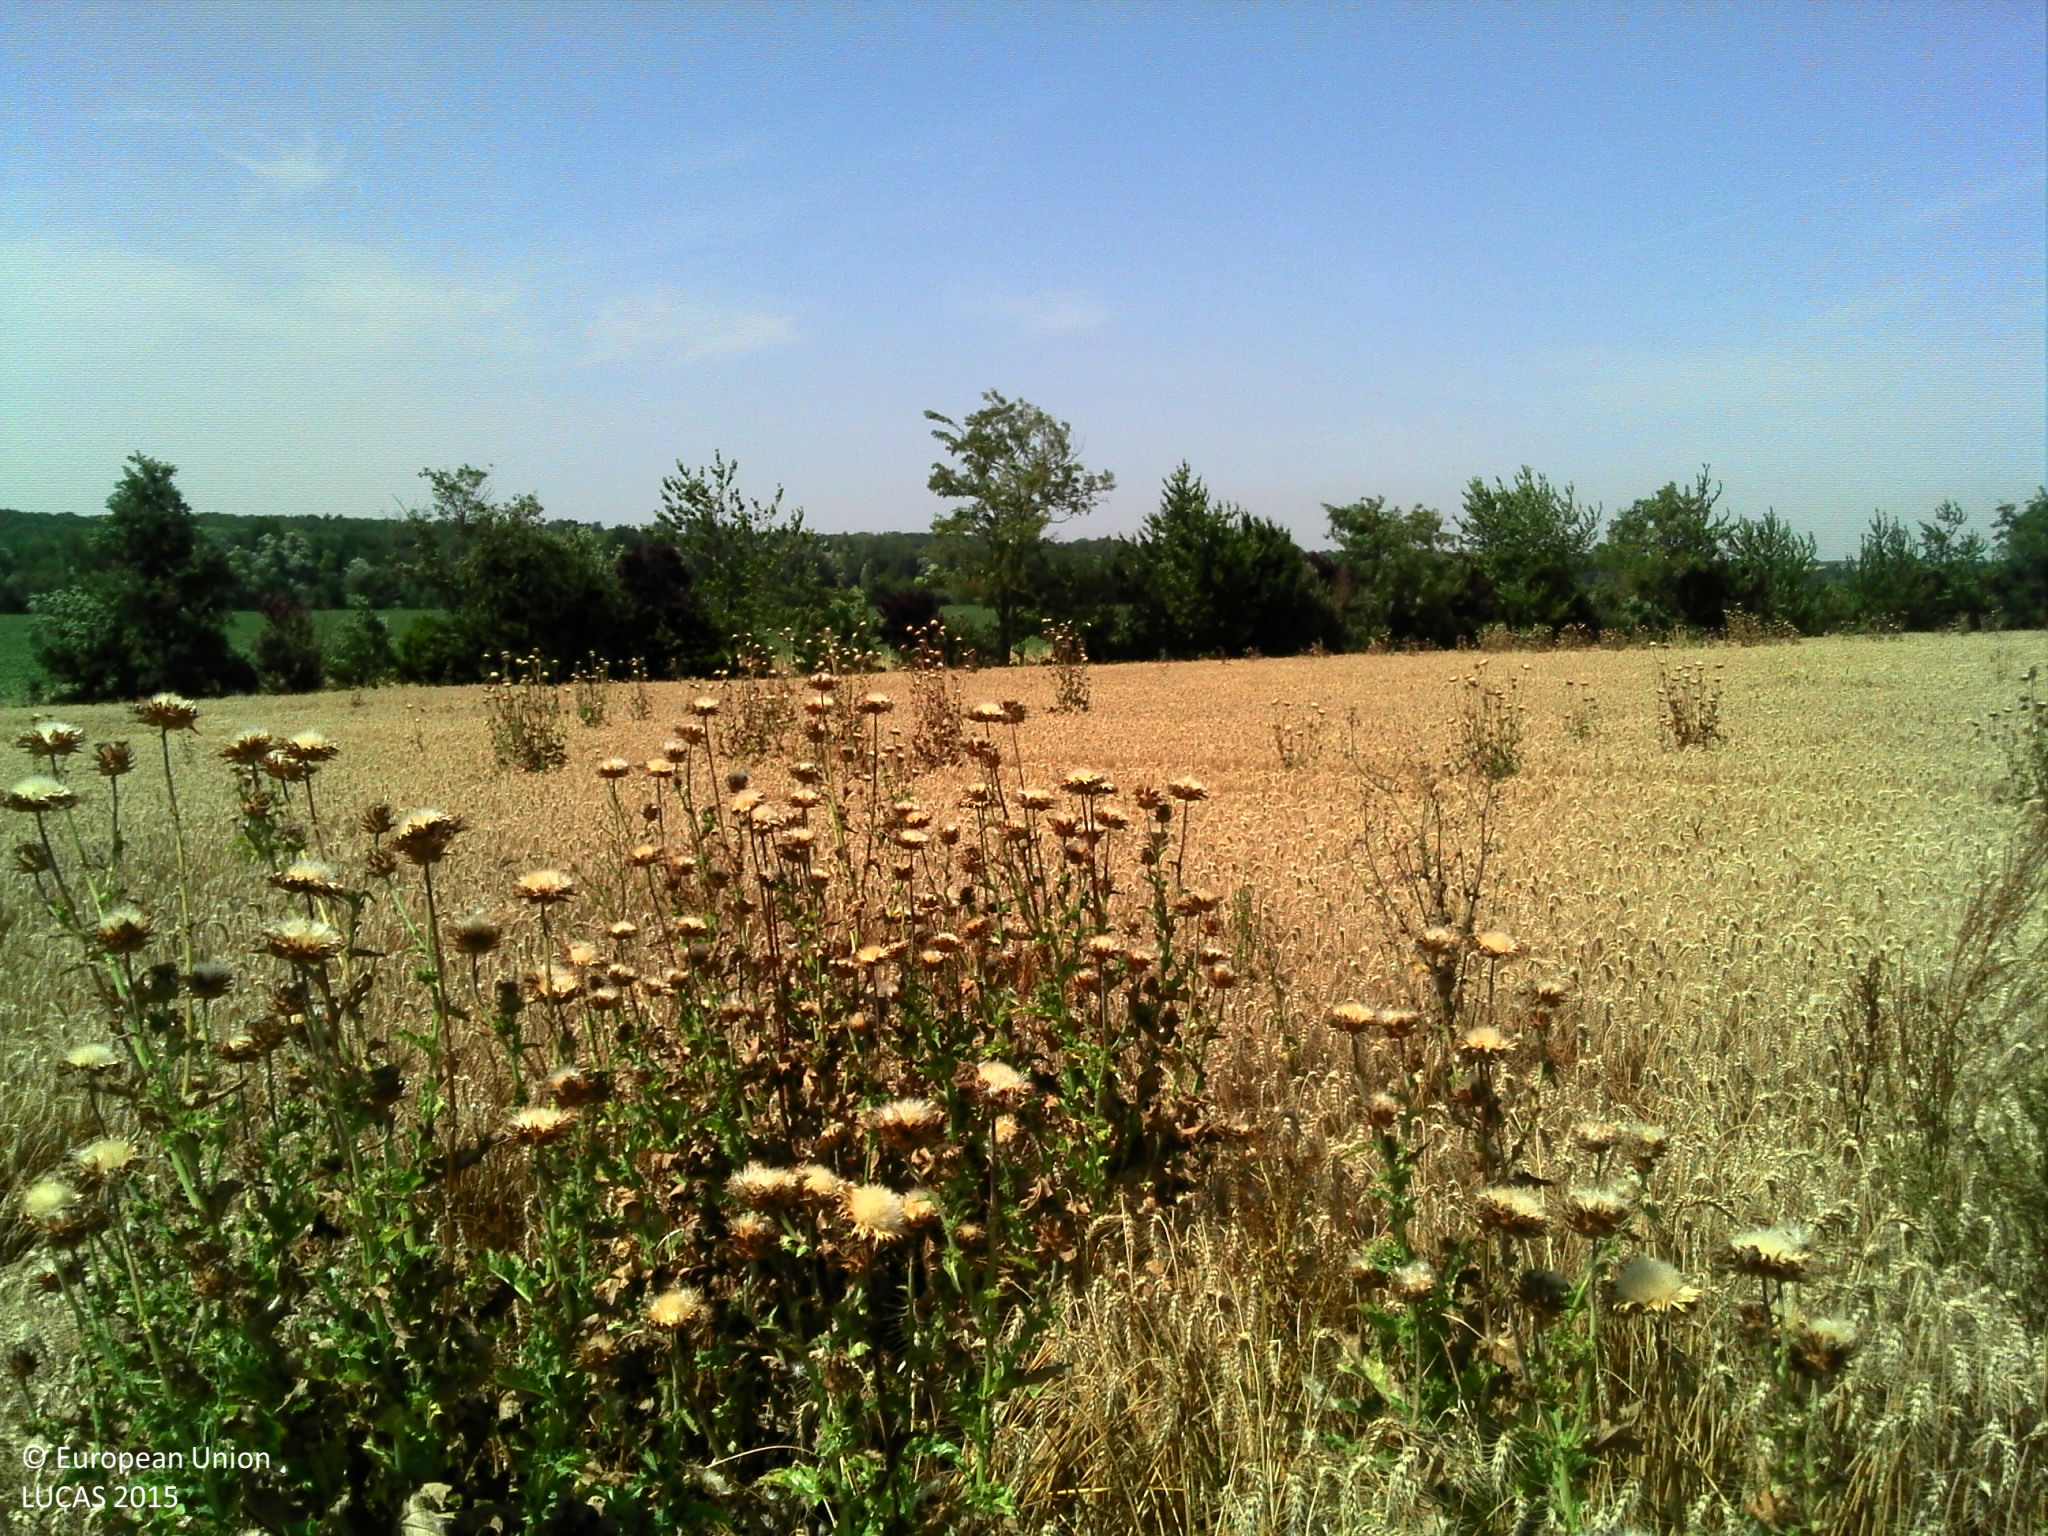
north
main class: Cropland
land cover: Common wheat
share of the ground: > 75 %
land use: Agriculture (excluding fallow land and kitchen gardens)
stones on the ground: < 10 %
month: July
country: FR
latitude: 43.5418
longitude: 1.0034
